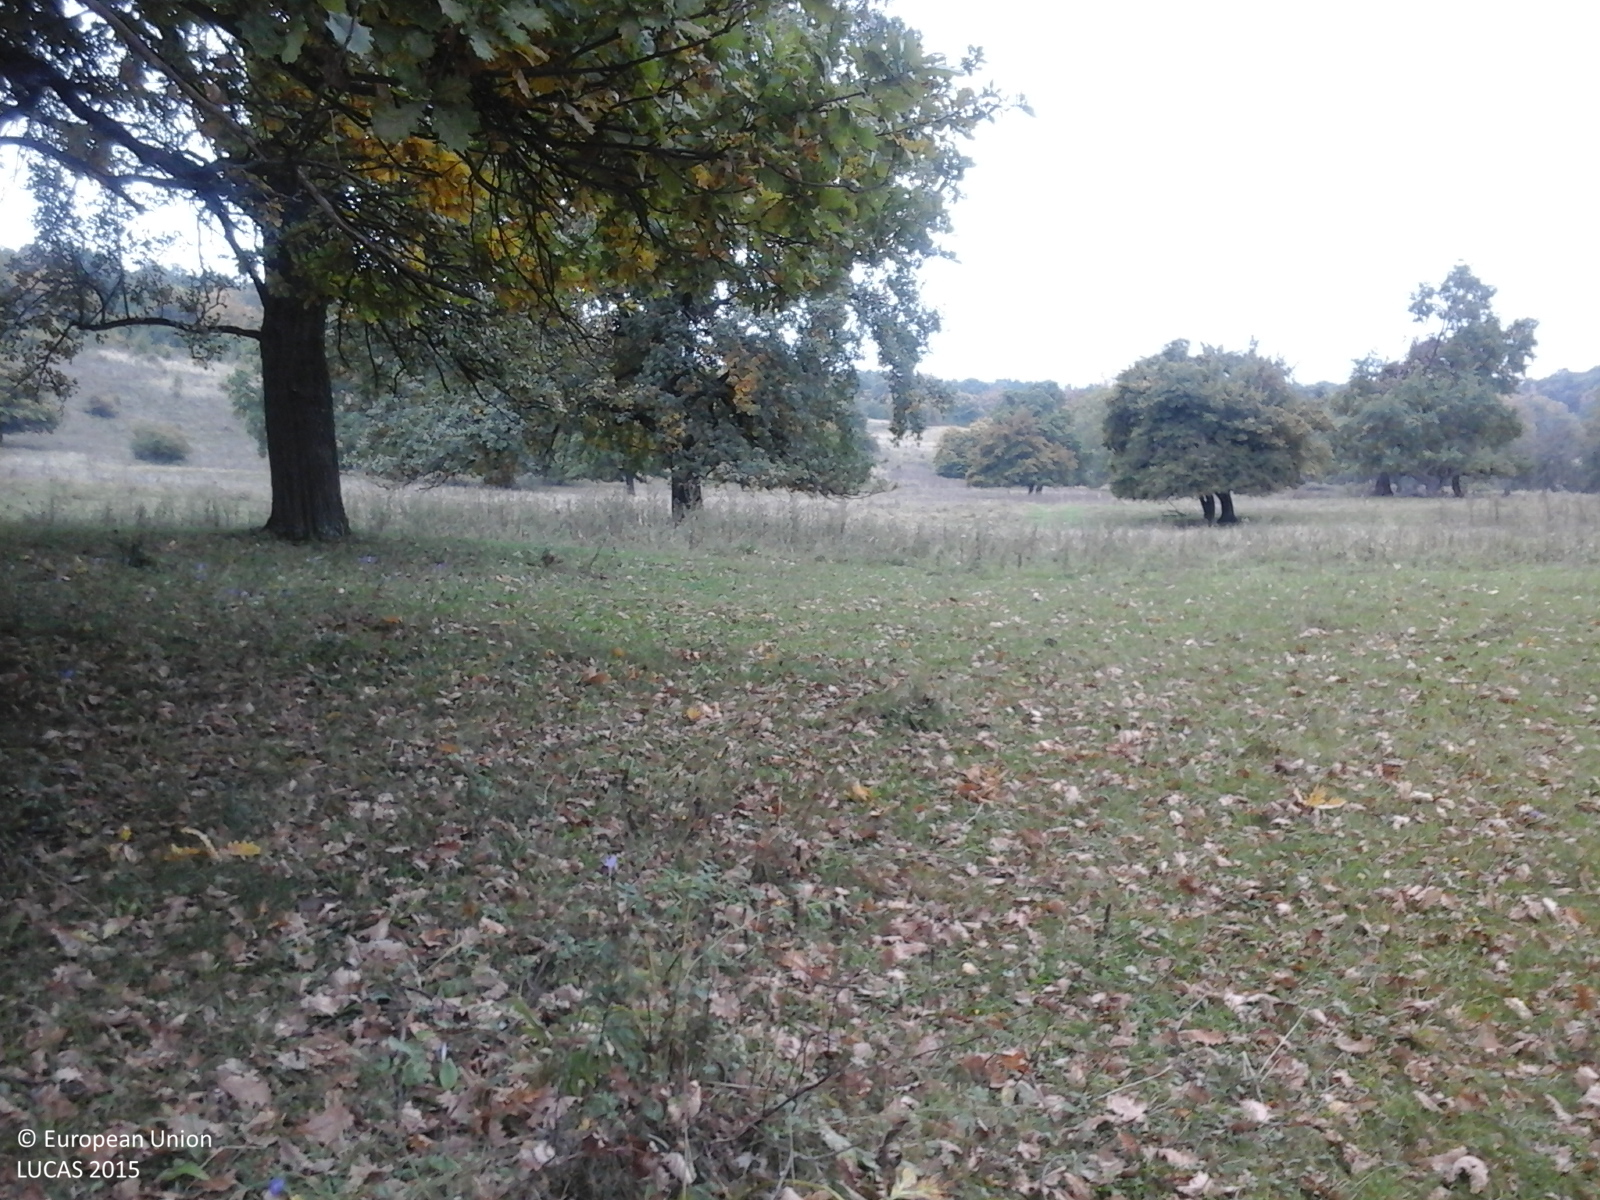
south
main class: Grassland
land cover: Grassland with sparse tree/shrub cover
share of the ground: > 75 %
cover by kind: herbaceous plants 95 %, broadleaved forest trees 5 %
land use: Agriculture (excluding fallow land and kitchen gardens)
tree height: > 5 m
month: October
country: RO
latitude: 46.0049
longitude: 25.2204
